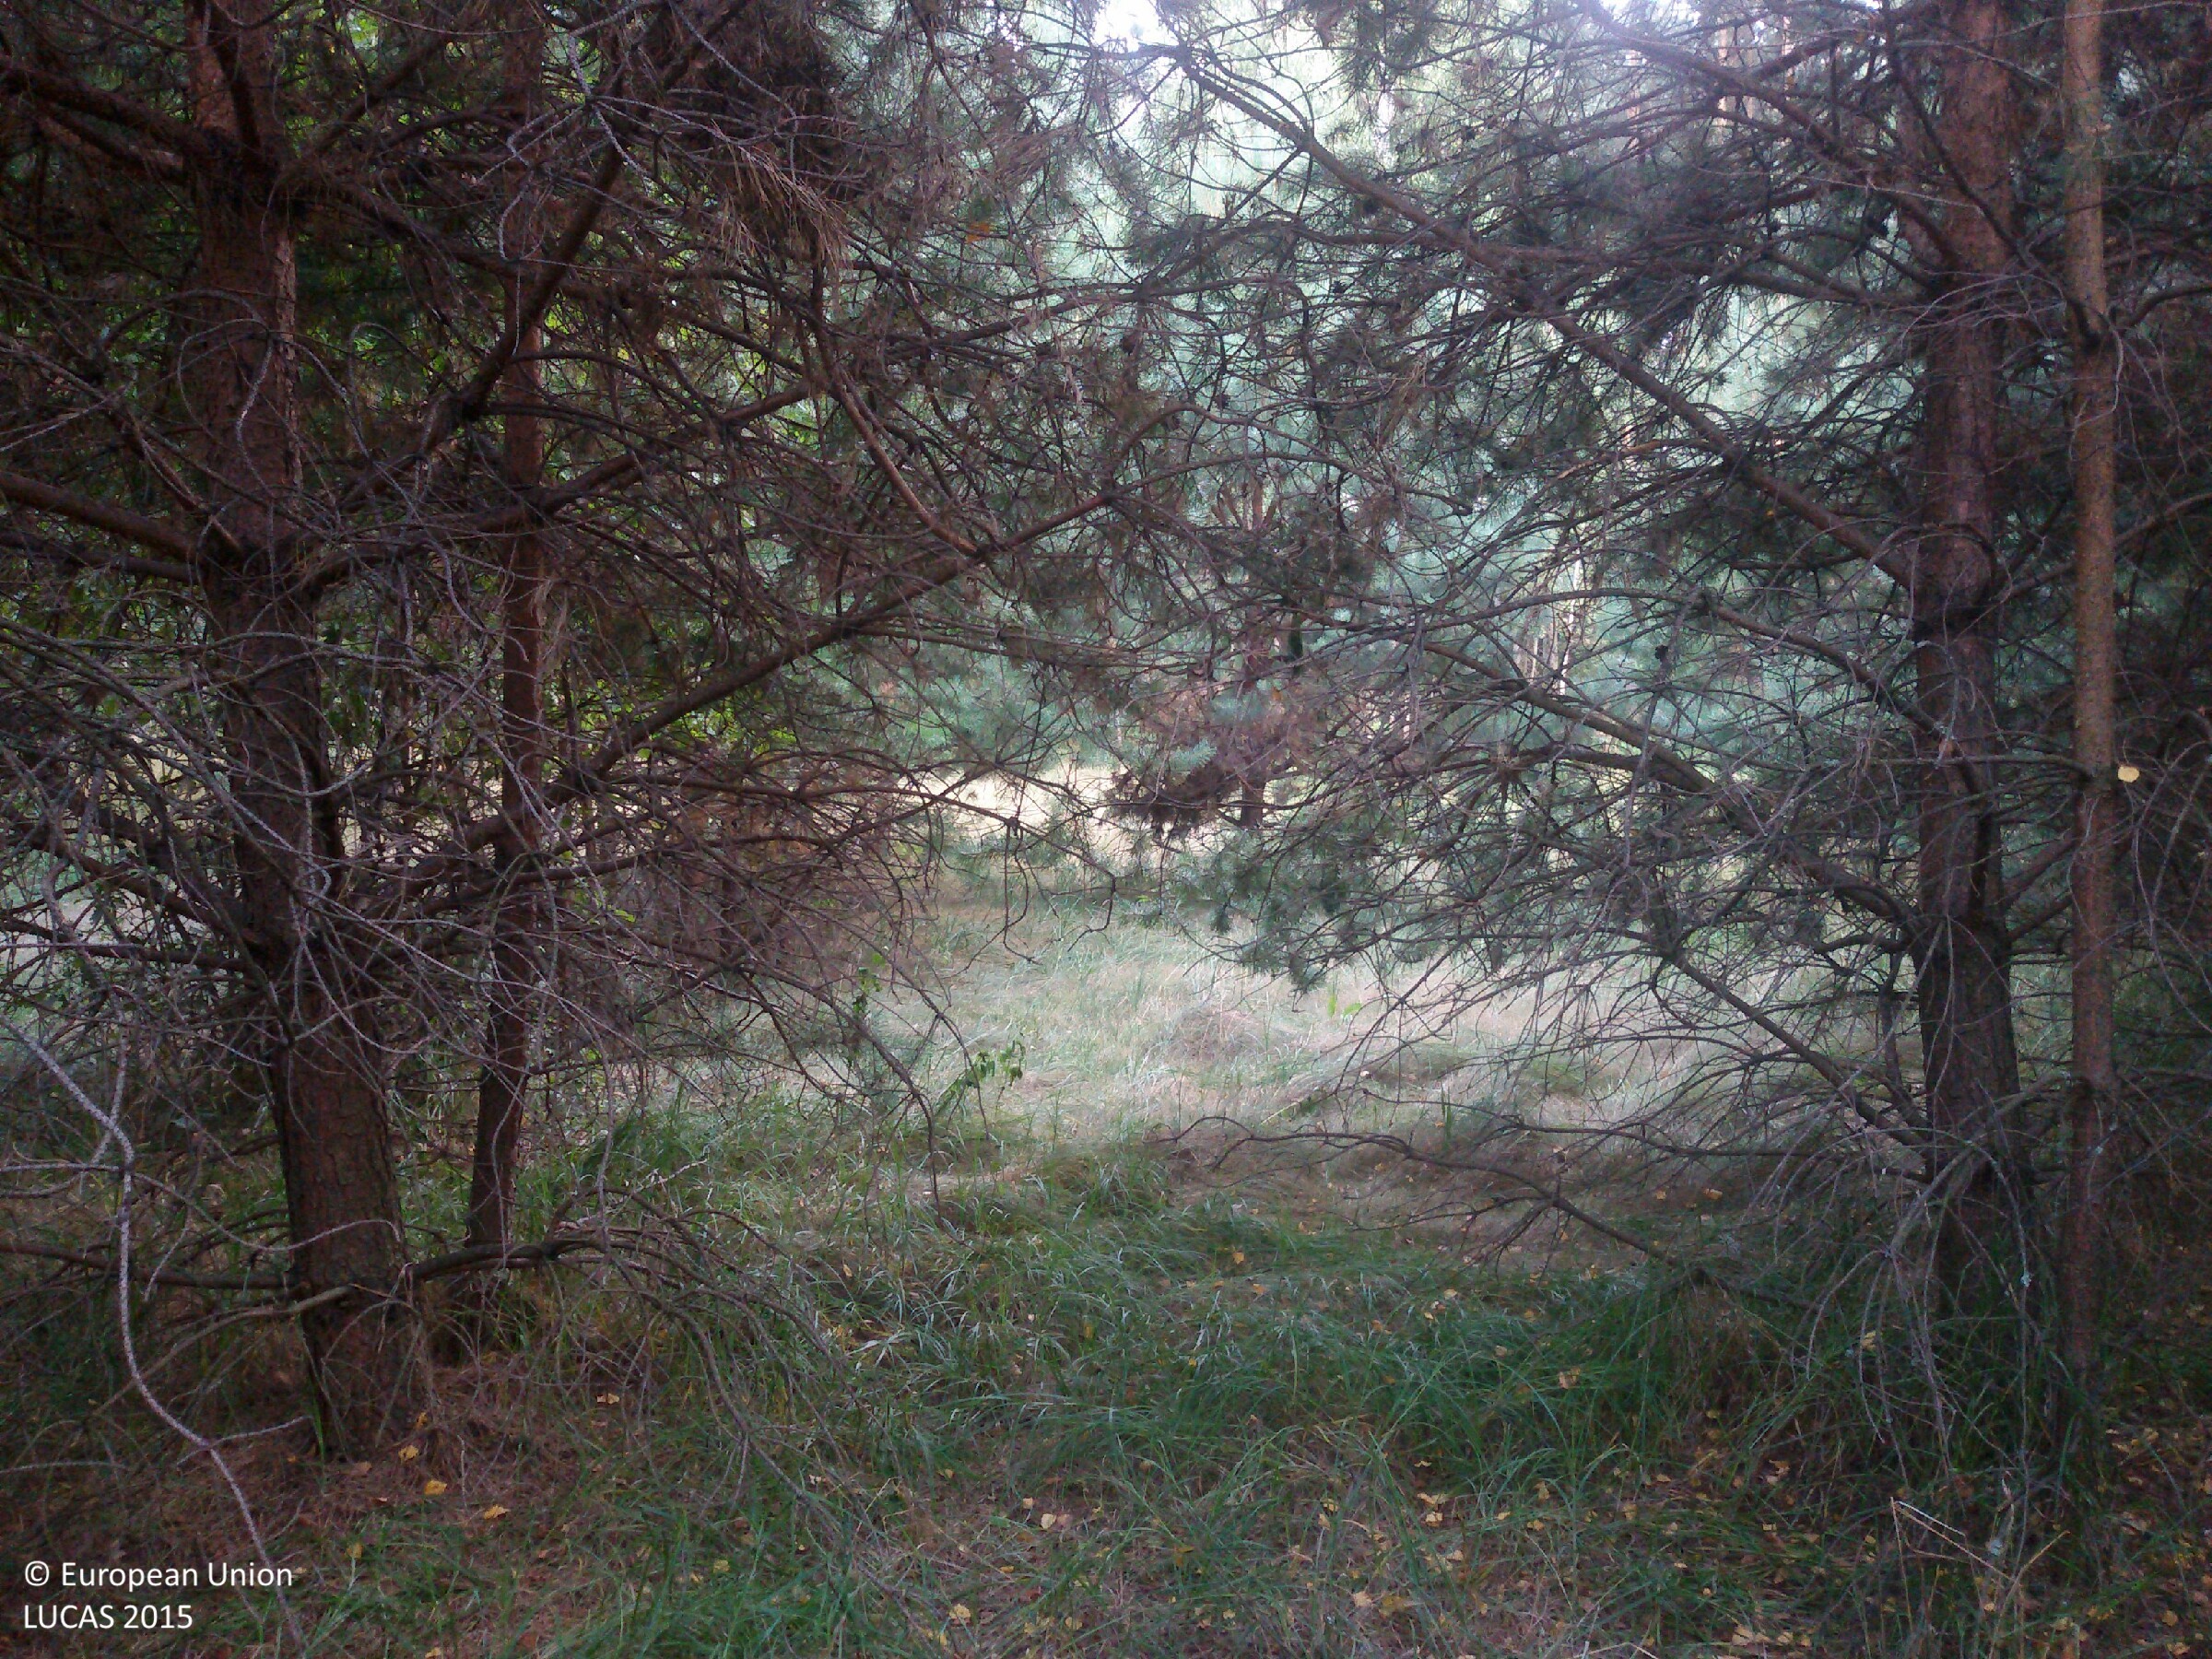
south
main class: Woodland
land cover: Pine dominated coniferous woodland
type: hemiboreal forest and nemoral coniferous forest and mixed broadleaved-coniferous forest
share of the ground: > 75 %
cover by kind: coniferous forest trees 80 %, herbaceous plants 15 %, broadleaved forest trees 5 %
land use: Forestry
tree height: > 5 m
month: August
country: PL
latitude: 51.1229
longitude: 20.9741
